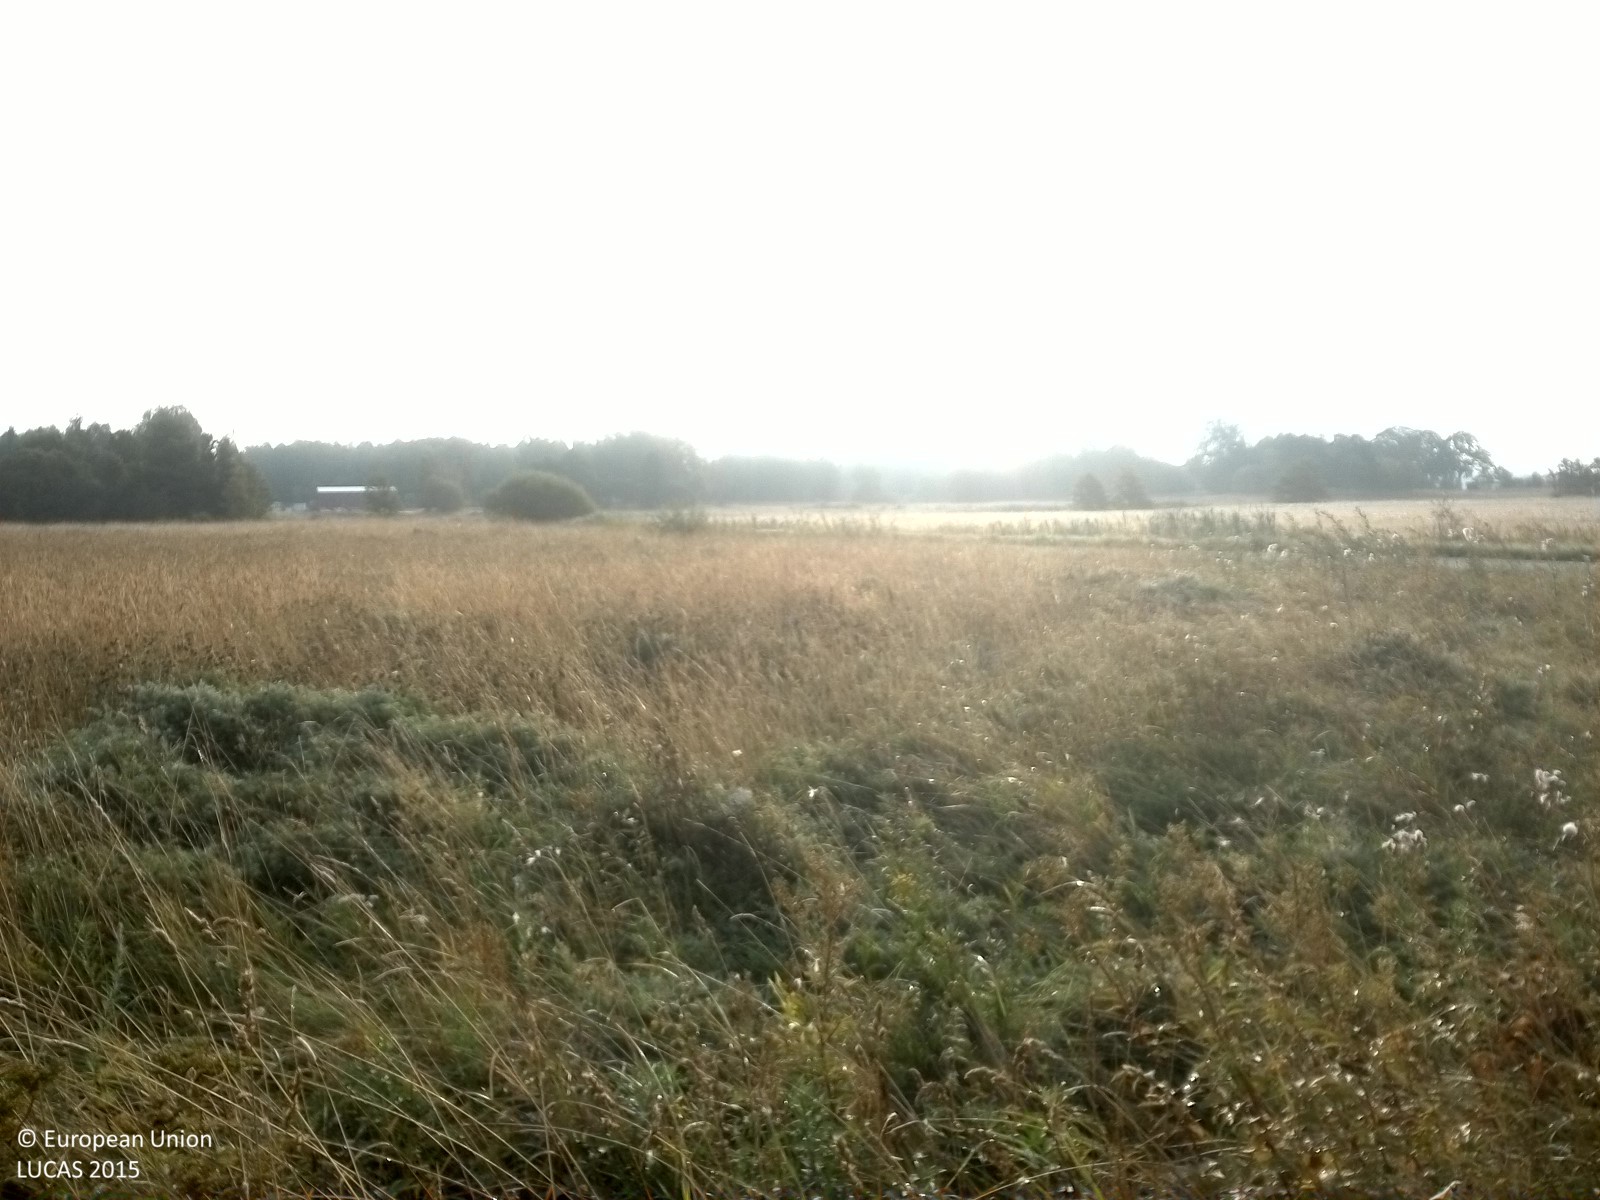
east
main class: Grassland
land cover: Spontaneously vegetated surfaces
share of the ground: > 75 %
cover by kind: herbaceous plants 100 %
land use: Fallow land
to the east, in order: Spontaneously vegetated surfaces; Ditches and canals; Grass margins; Paved roads, cycling and walking lanes; Grass margins; Ditches and canals; Grass margins; Oats; Grass margins; Rivers and streams; Grass margins; Grassland without tree/shrub cover; Ditches and canals; Grassland without tree/shrub cover
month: August
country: SE
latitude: 59.3324
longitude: 15.5285
